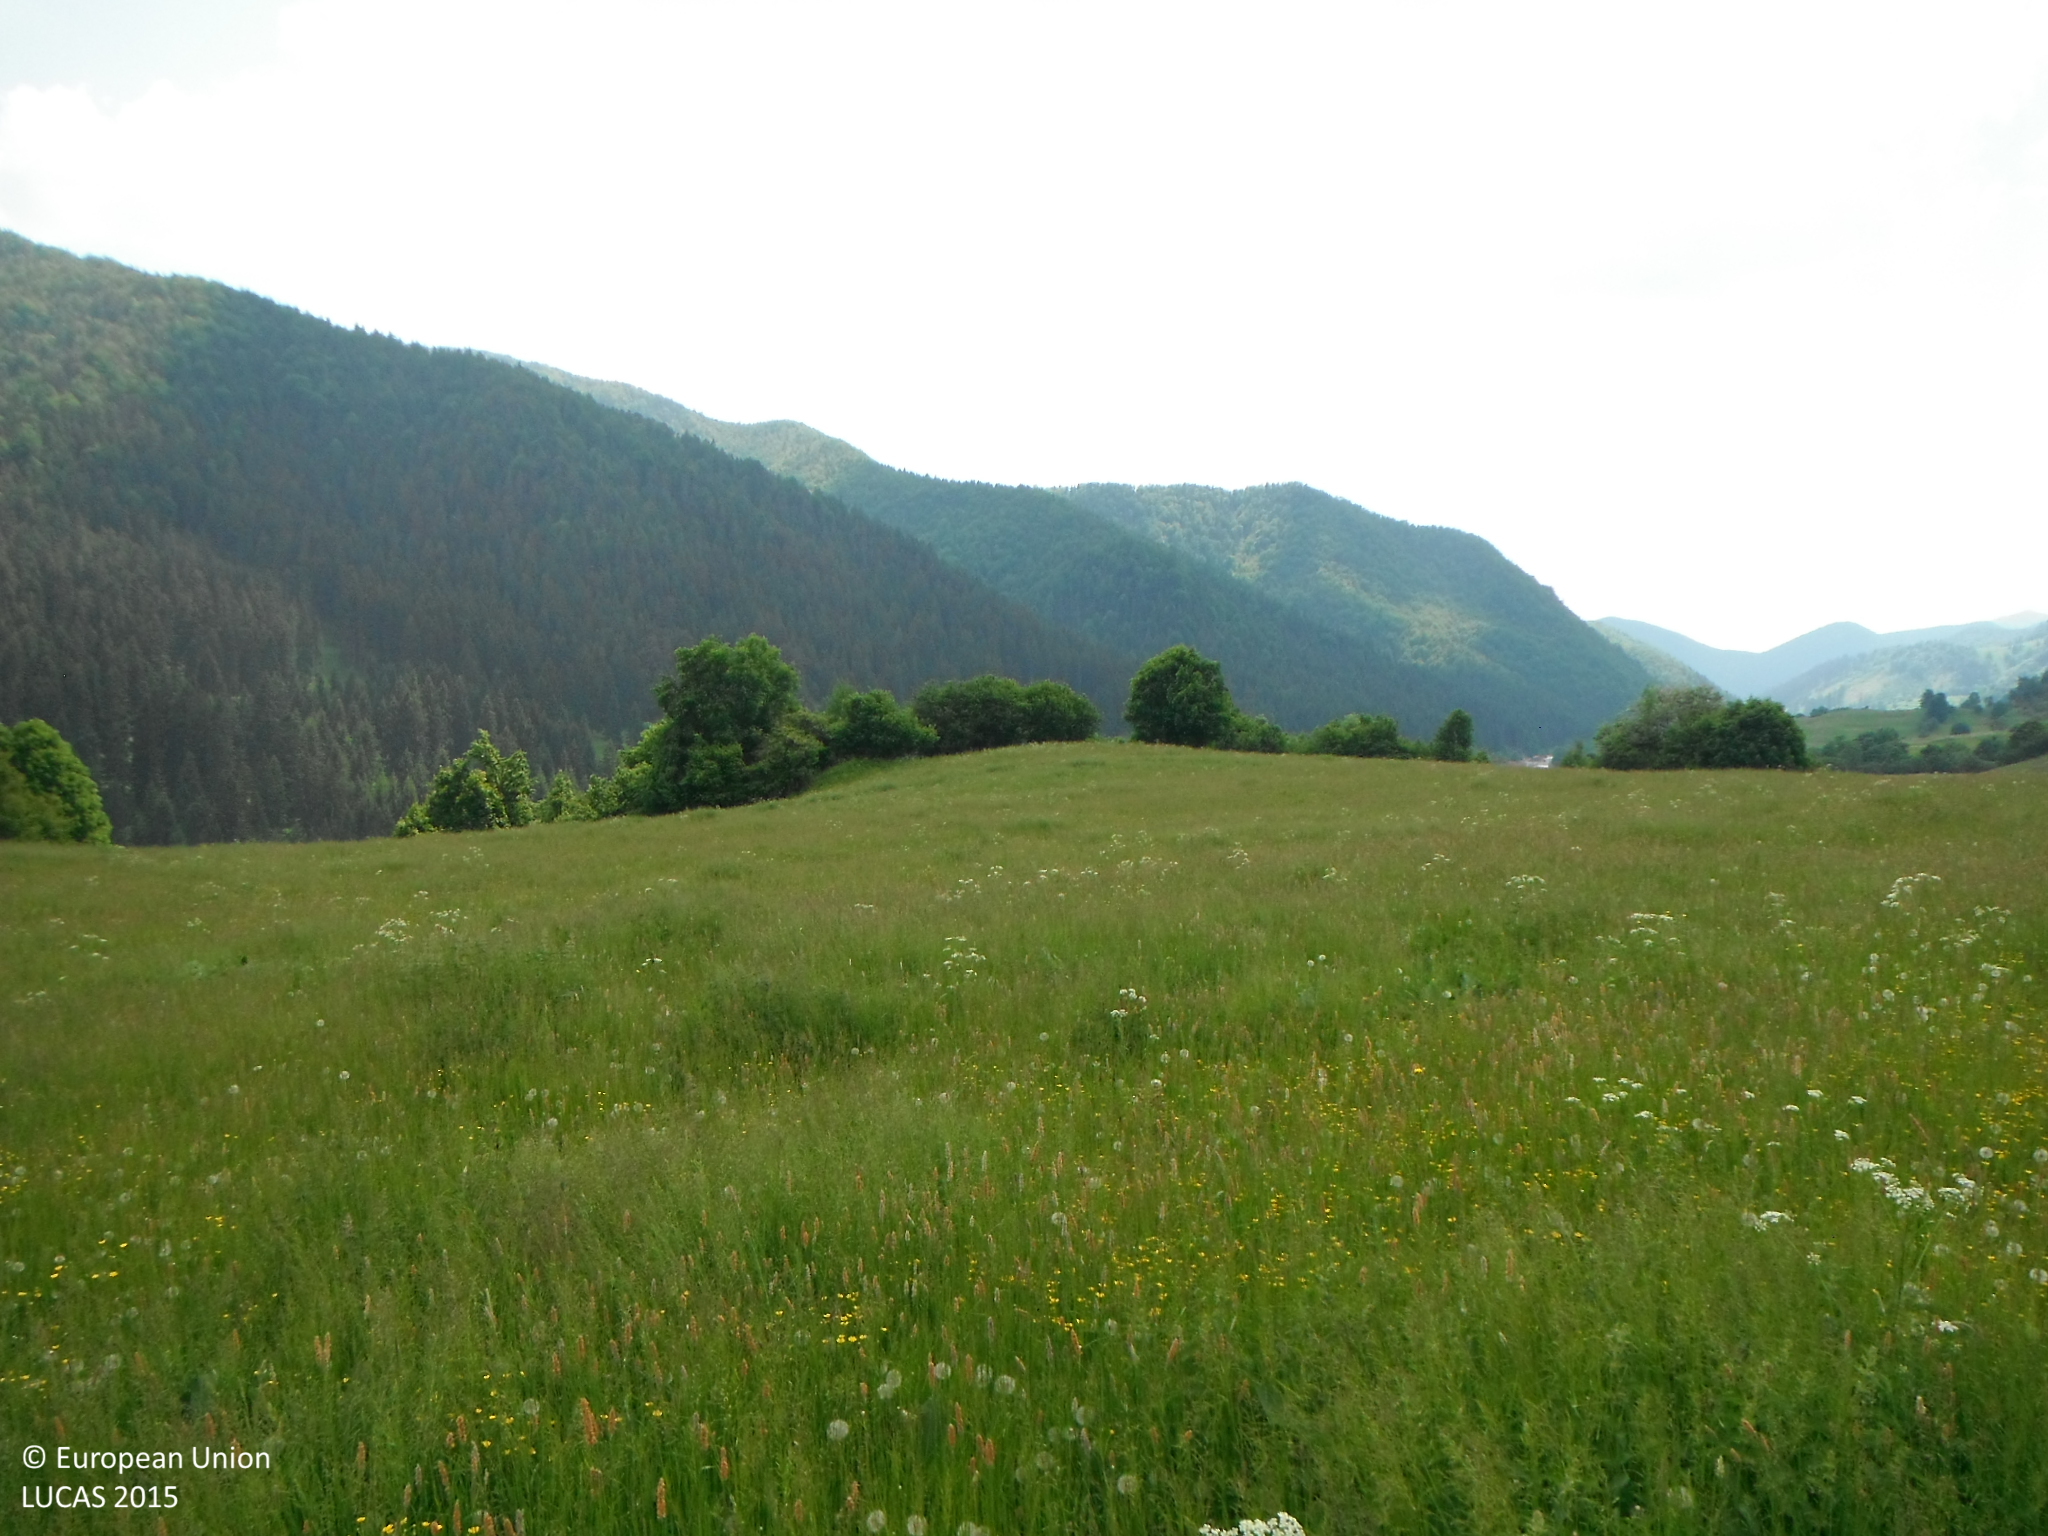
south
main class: Grassland
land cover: Grassland without tree/shrub cover
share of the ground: > 75 %
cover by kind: herbaceous plants 100 %
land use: Agriculture (excluding fallow land and kitchen gardens)
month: June
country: SK
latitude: 48.9261
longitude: 19.1812
